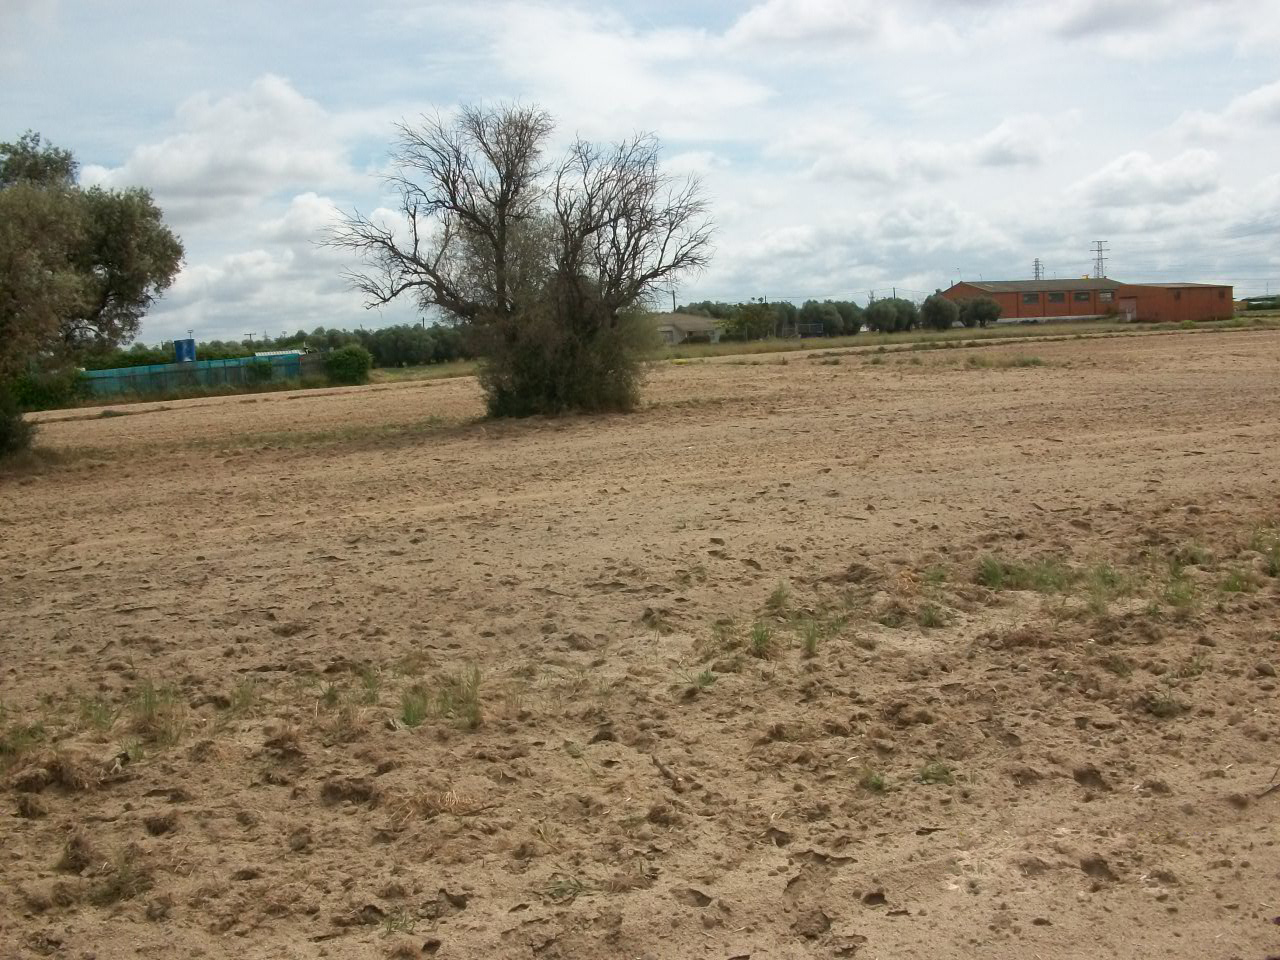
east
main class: Cropland
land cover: Olive groves
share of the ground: 25 - 50 %
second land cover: Other bare soil
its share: > 75 %
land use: Agriculture (excluding fallow land and kitchen gardens)
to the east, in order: Olive groves; Other bare soil; Grass margins; Other bare soil; Grass margins; Grassland without tree/shrub cover; Tracks; Grass margins; Oats; Grass margins; Barley; Abandoned hedges; Artificial constructions in urban areas; Shruby margins; Electric lines; Olive groves; Electric lines; Common wheat
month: April
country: ES
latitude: 40.2896
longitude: -3.8358
